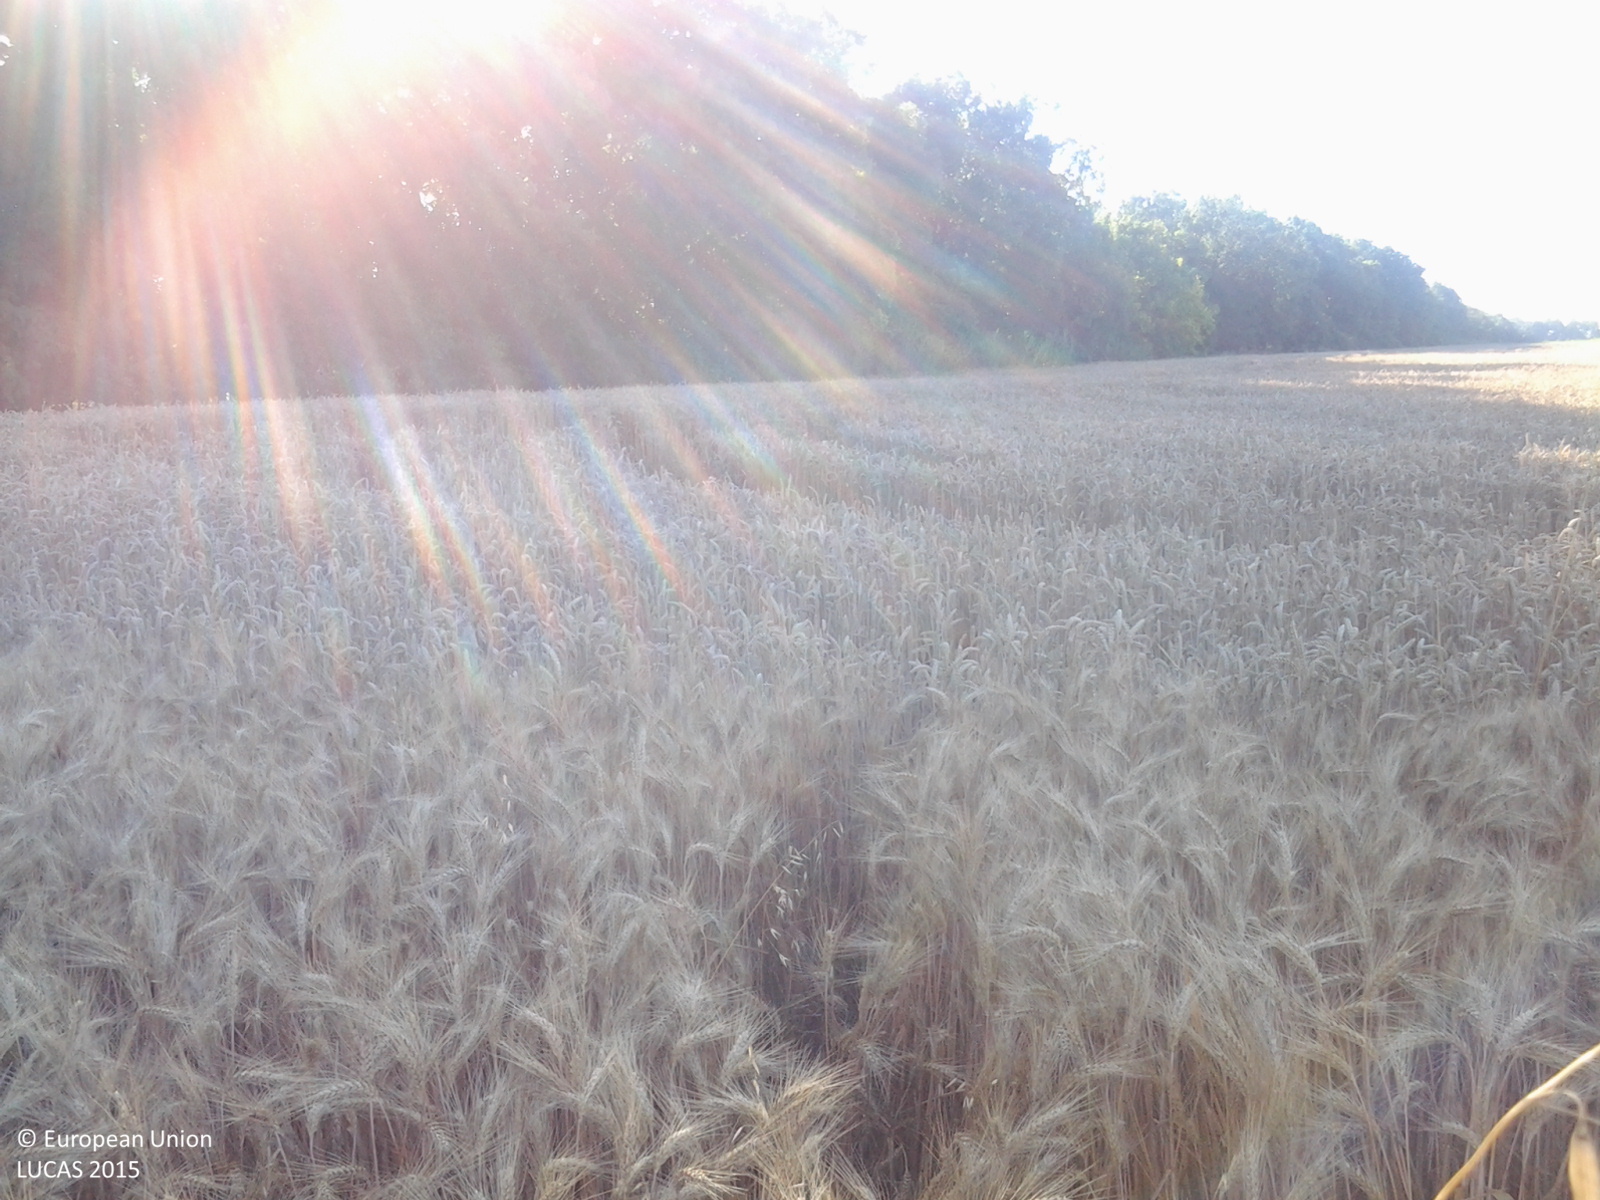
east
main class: Cropland
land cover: Common wheat
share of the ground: > 75 %
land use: Agriculture (excluding fallow land and kitchen gardens)
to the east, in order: Common wheat; Grass margins; Broadleaved woodland; Grass margins; Ditches and canals; Grass margins; Paved roads, cycling and walking lanes; Grass margins; Lines of trees; Tracks; Lines of trees; Grass margins; Electric lines; Maize; Tracks; Other fibre and oleaginous crops
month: July
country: HU
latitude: 47.0473
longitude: 20.5200
